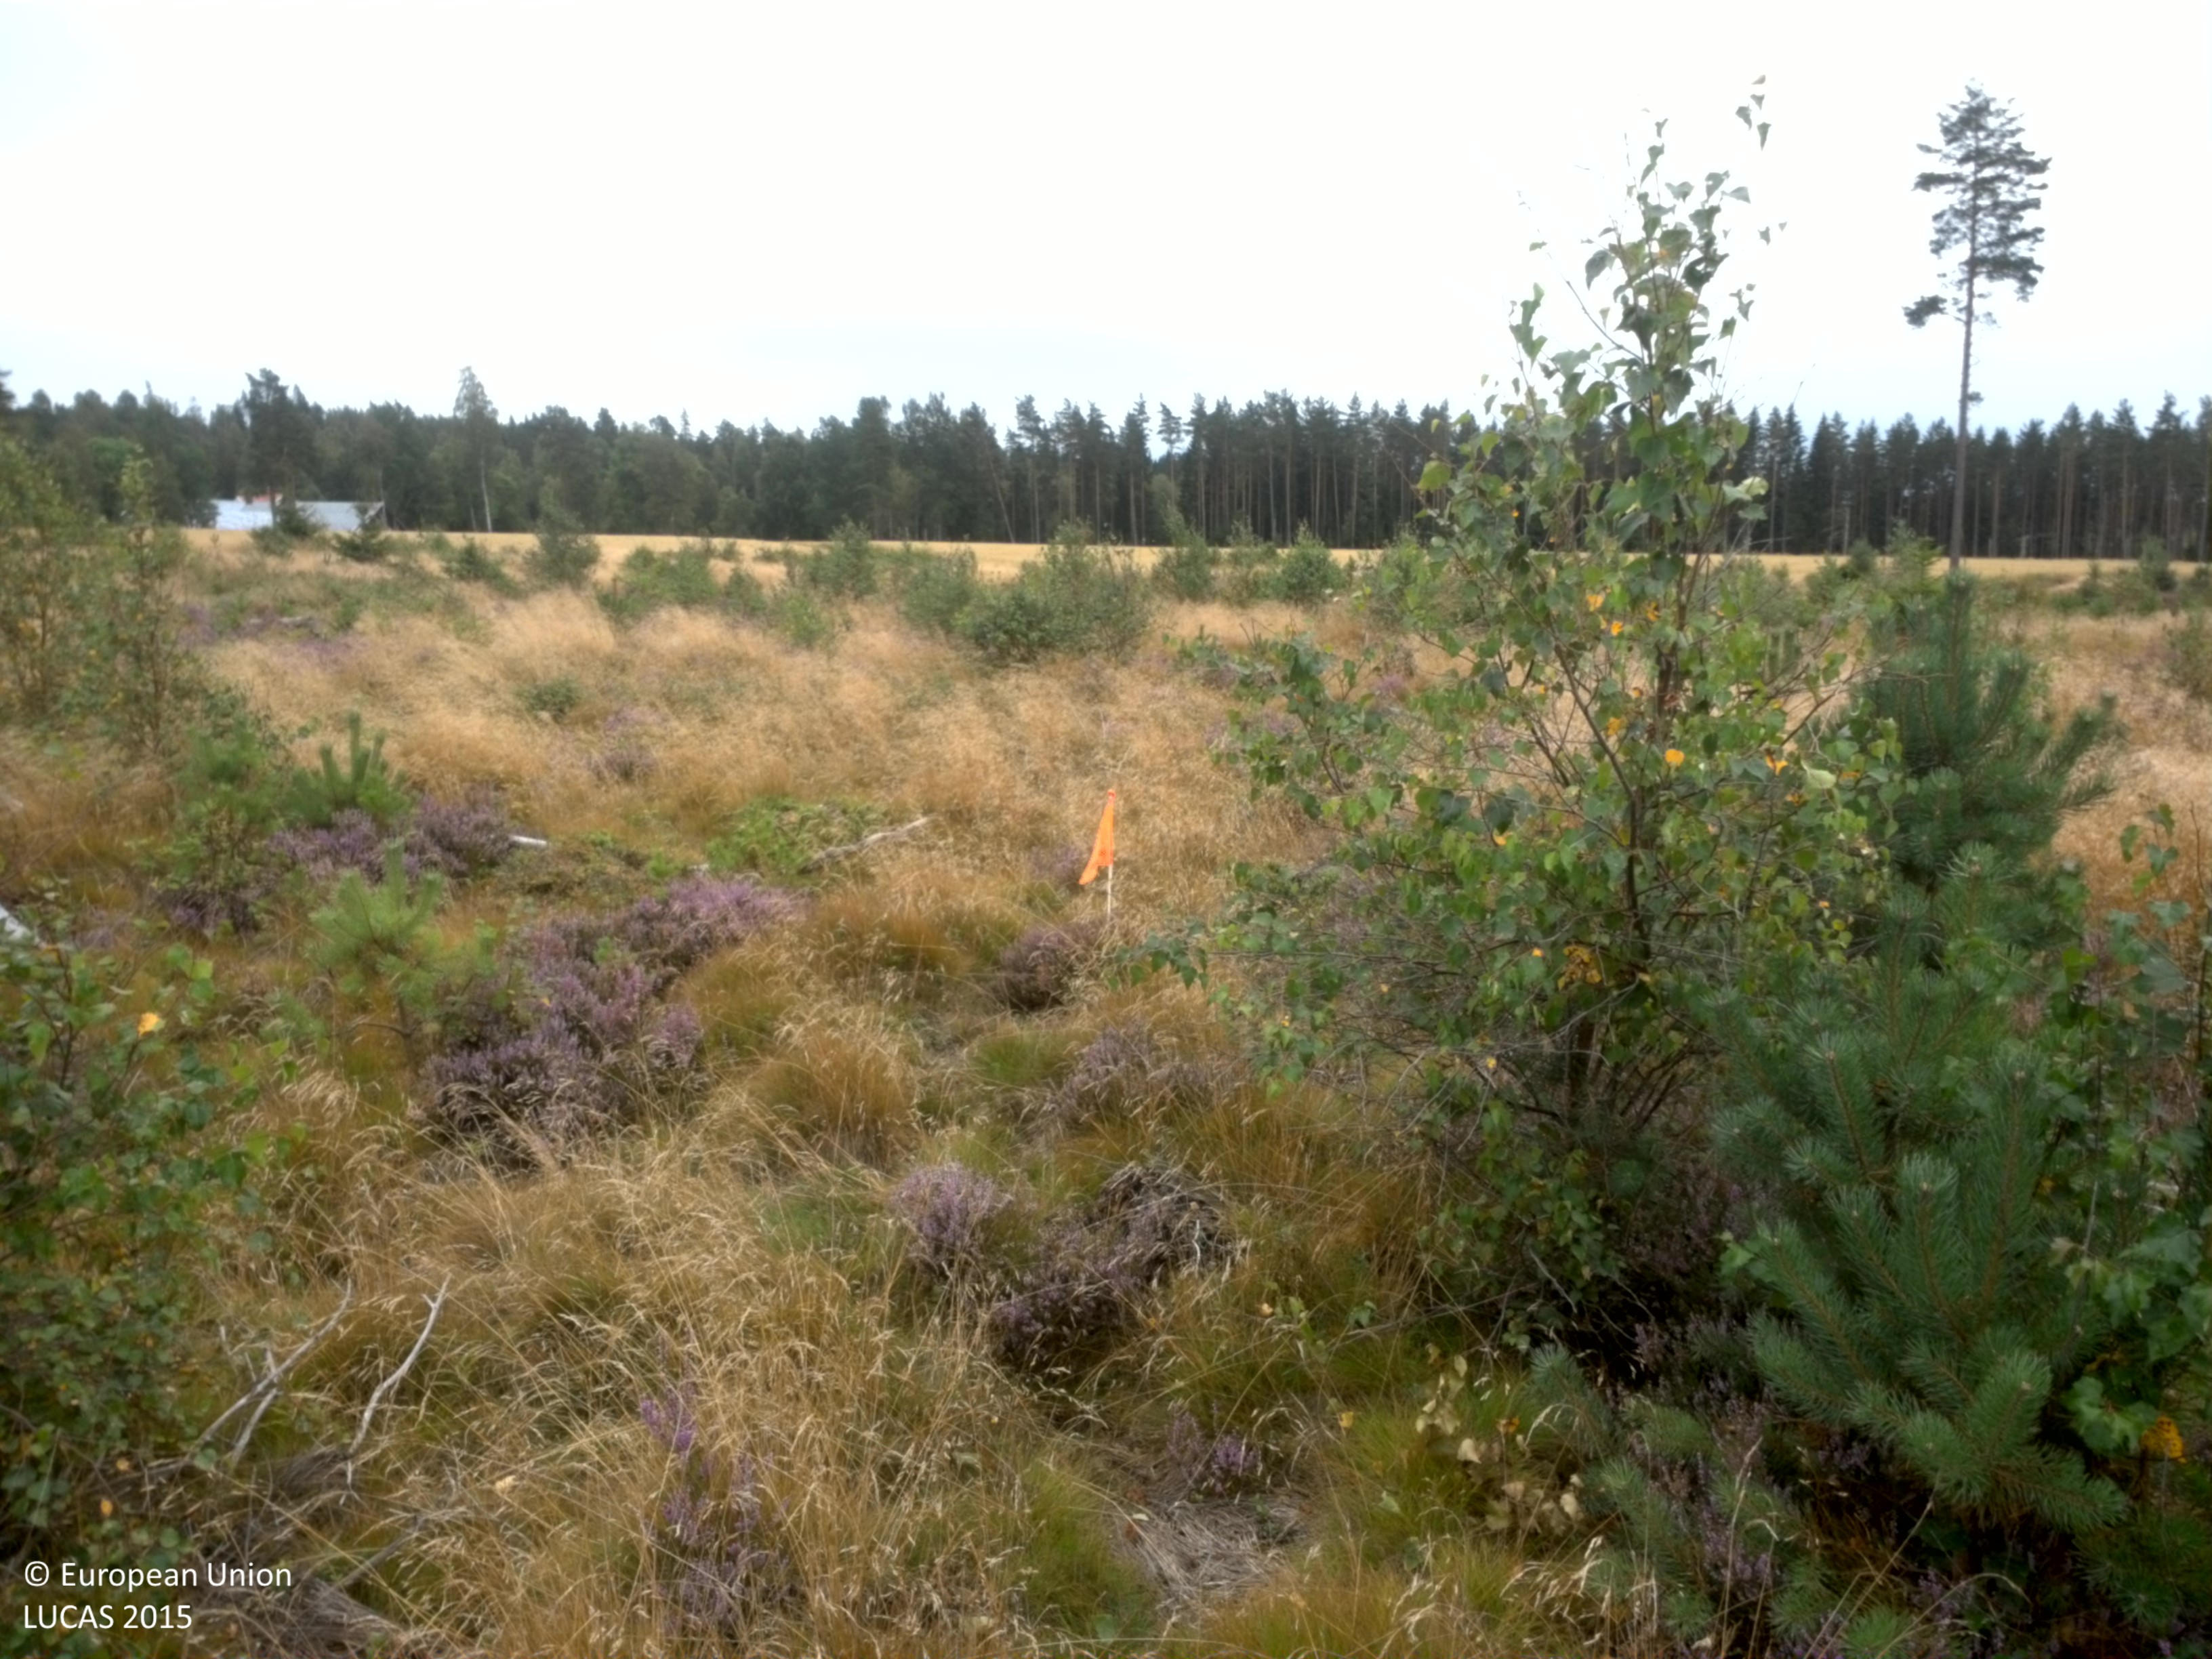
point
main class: Woodland
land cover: Pine dominated mixed woodland
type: boreal forest
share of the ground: 10 - 25 %
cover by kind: herbaceous plants 60 %, coniferous forest trees 15 %, shrubs 15 %, broadleaved forest trees 10 %
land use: Forestry
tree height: < 5 m
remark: Clear cut
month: August
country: SE
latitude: 57.8751
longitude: 13.8896
